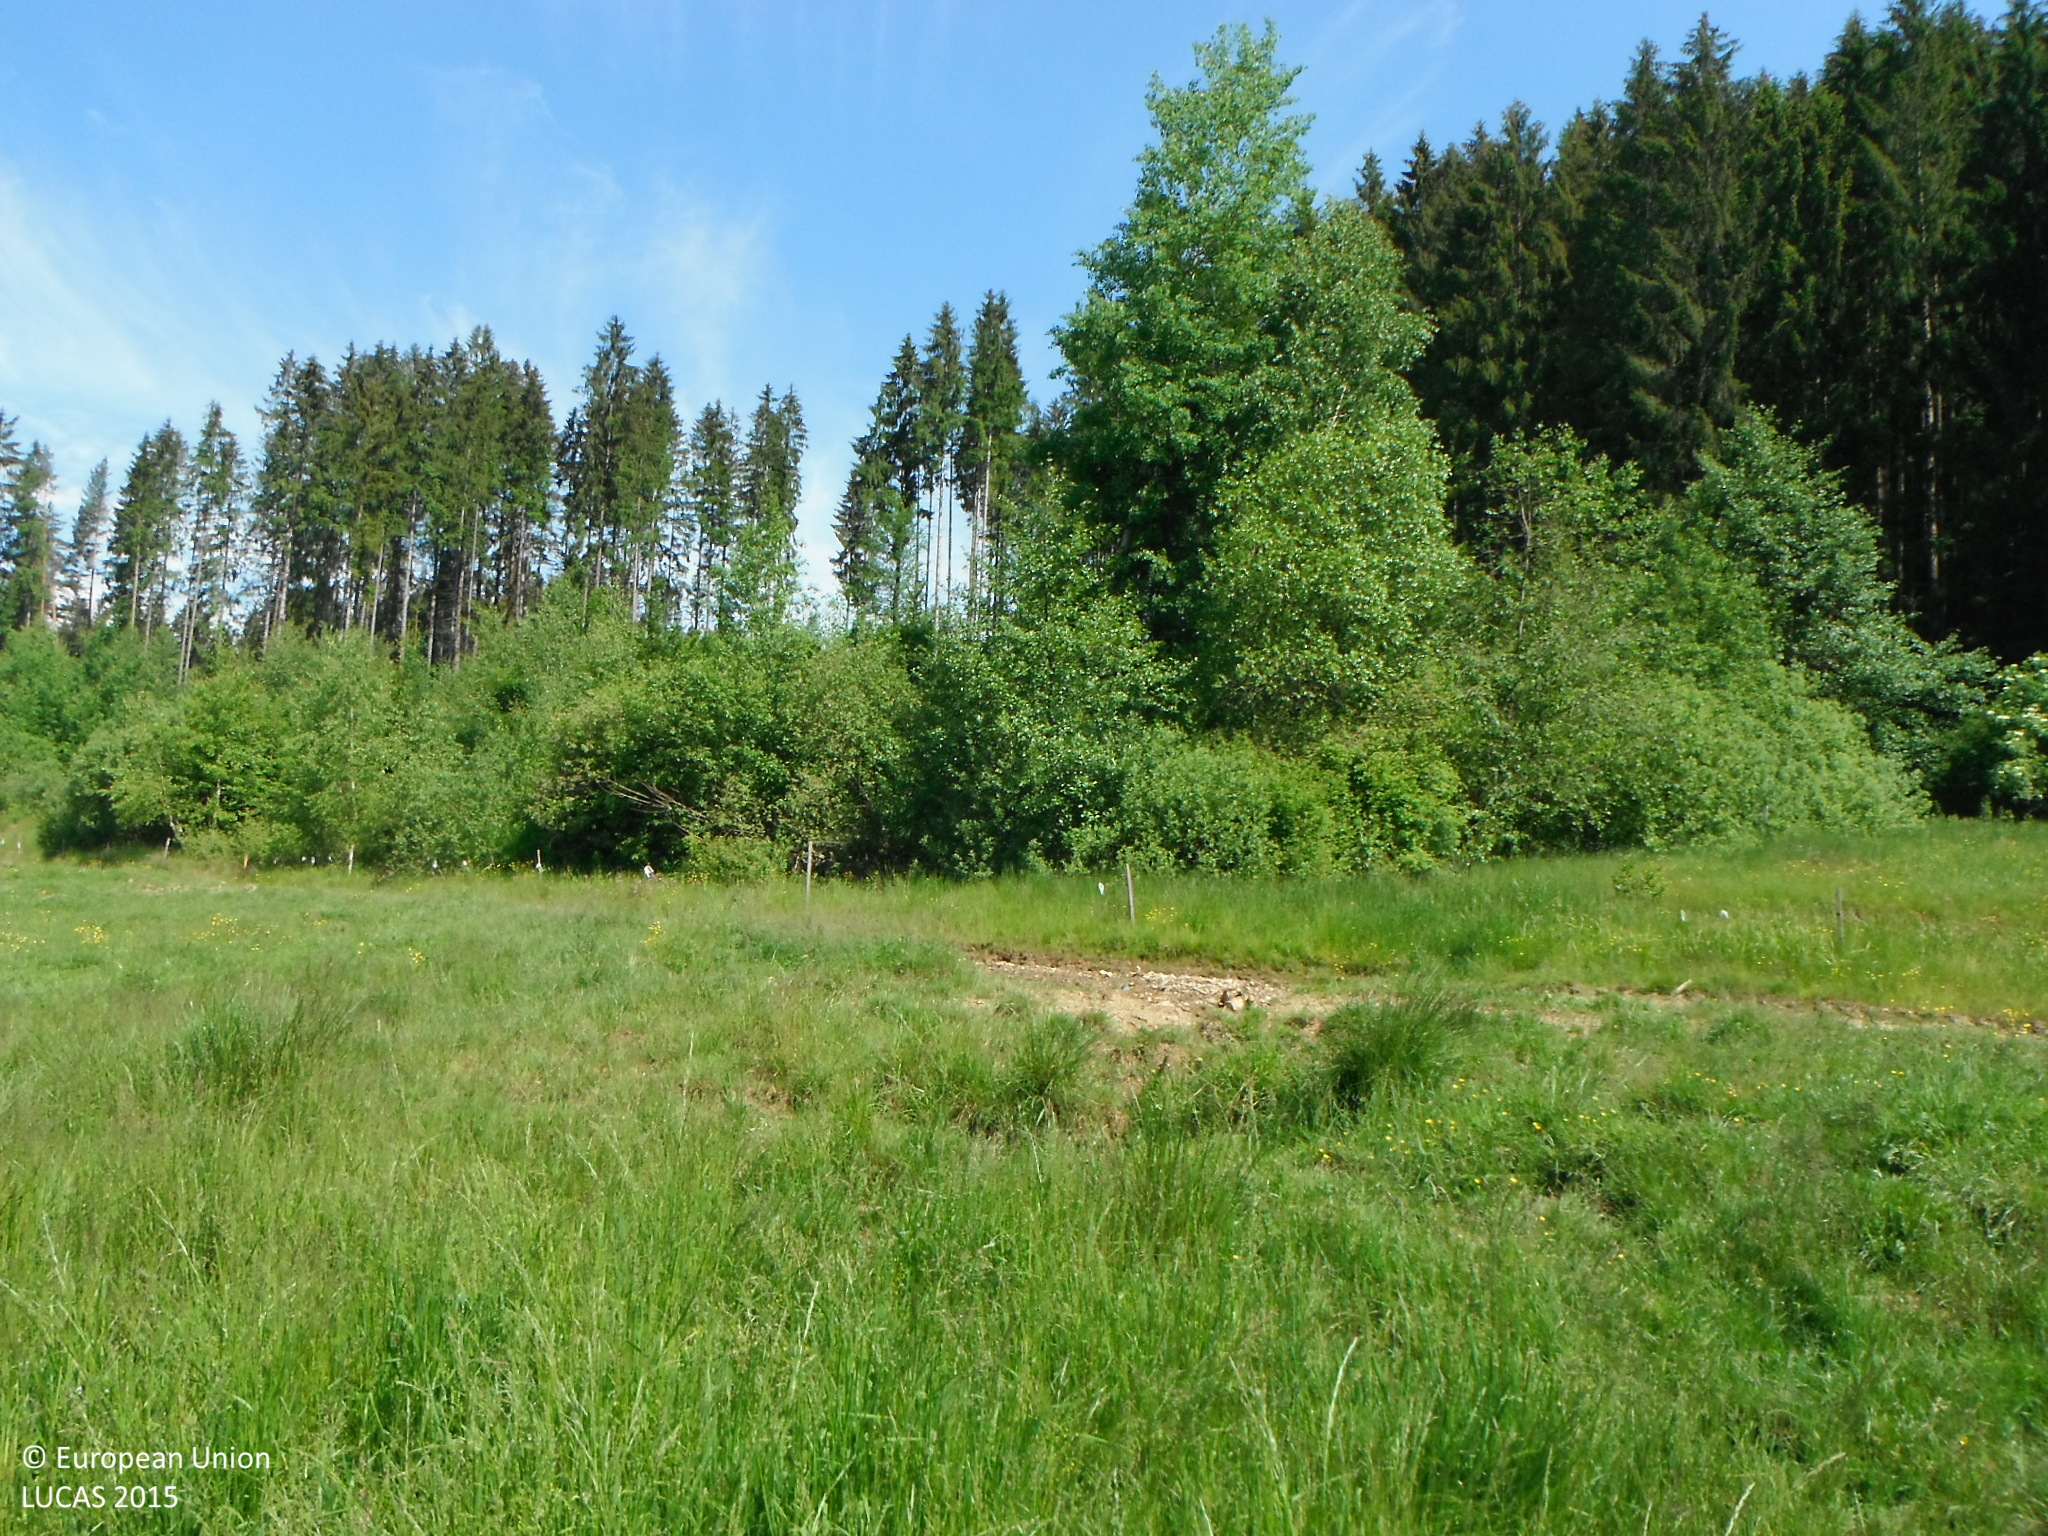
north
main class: Grassland
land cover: Grassland without tree/shrub cover
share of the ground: > 75 %
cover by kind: herbaceous plants 100 %
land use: Agriculture (excluding fallow land and kitchen gardens)
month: June
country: SK
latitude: 48.7863
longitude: 19.7595
